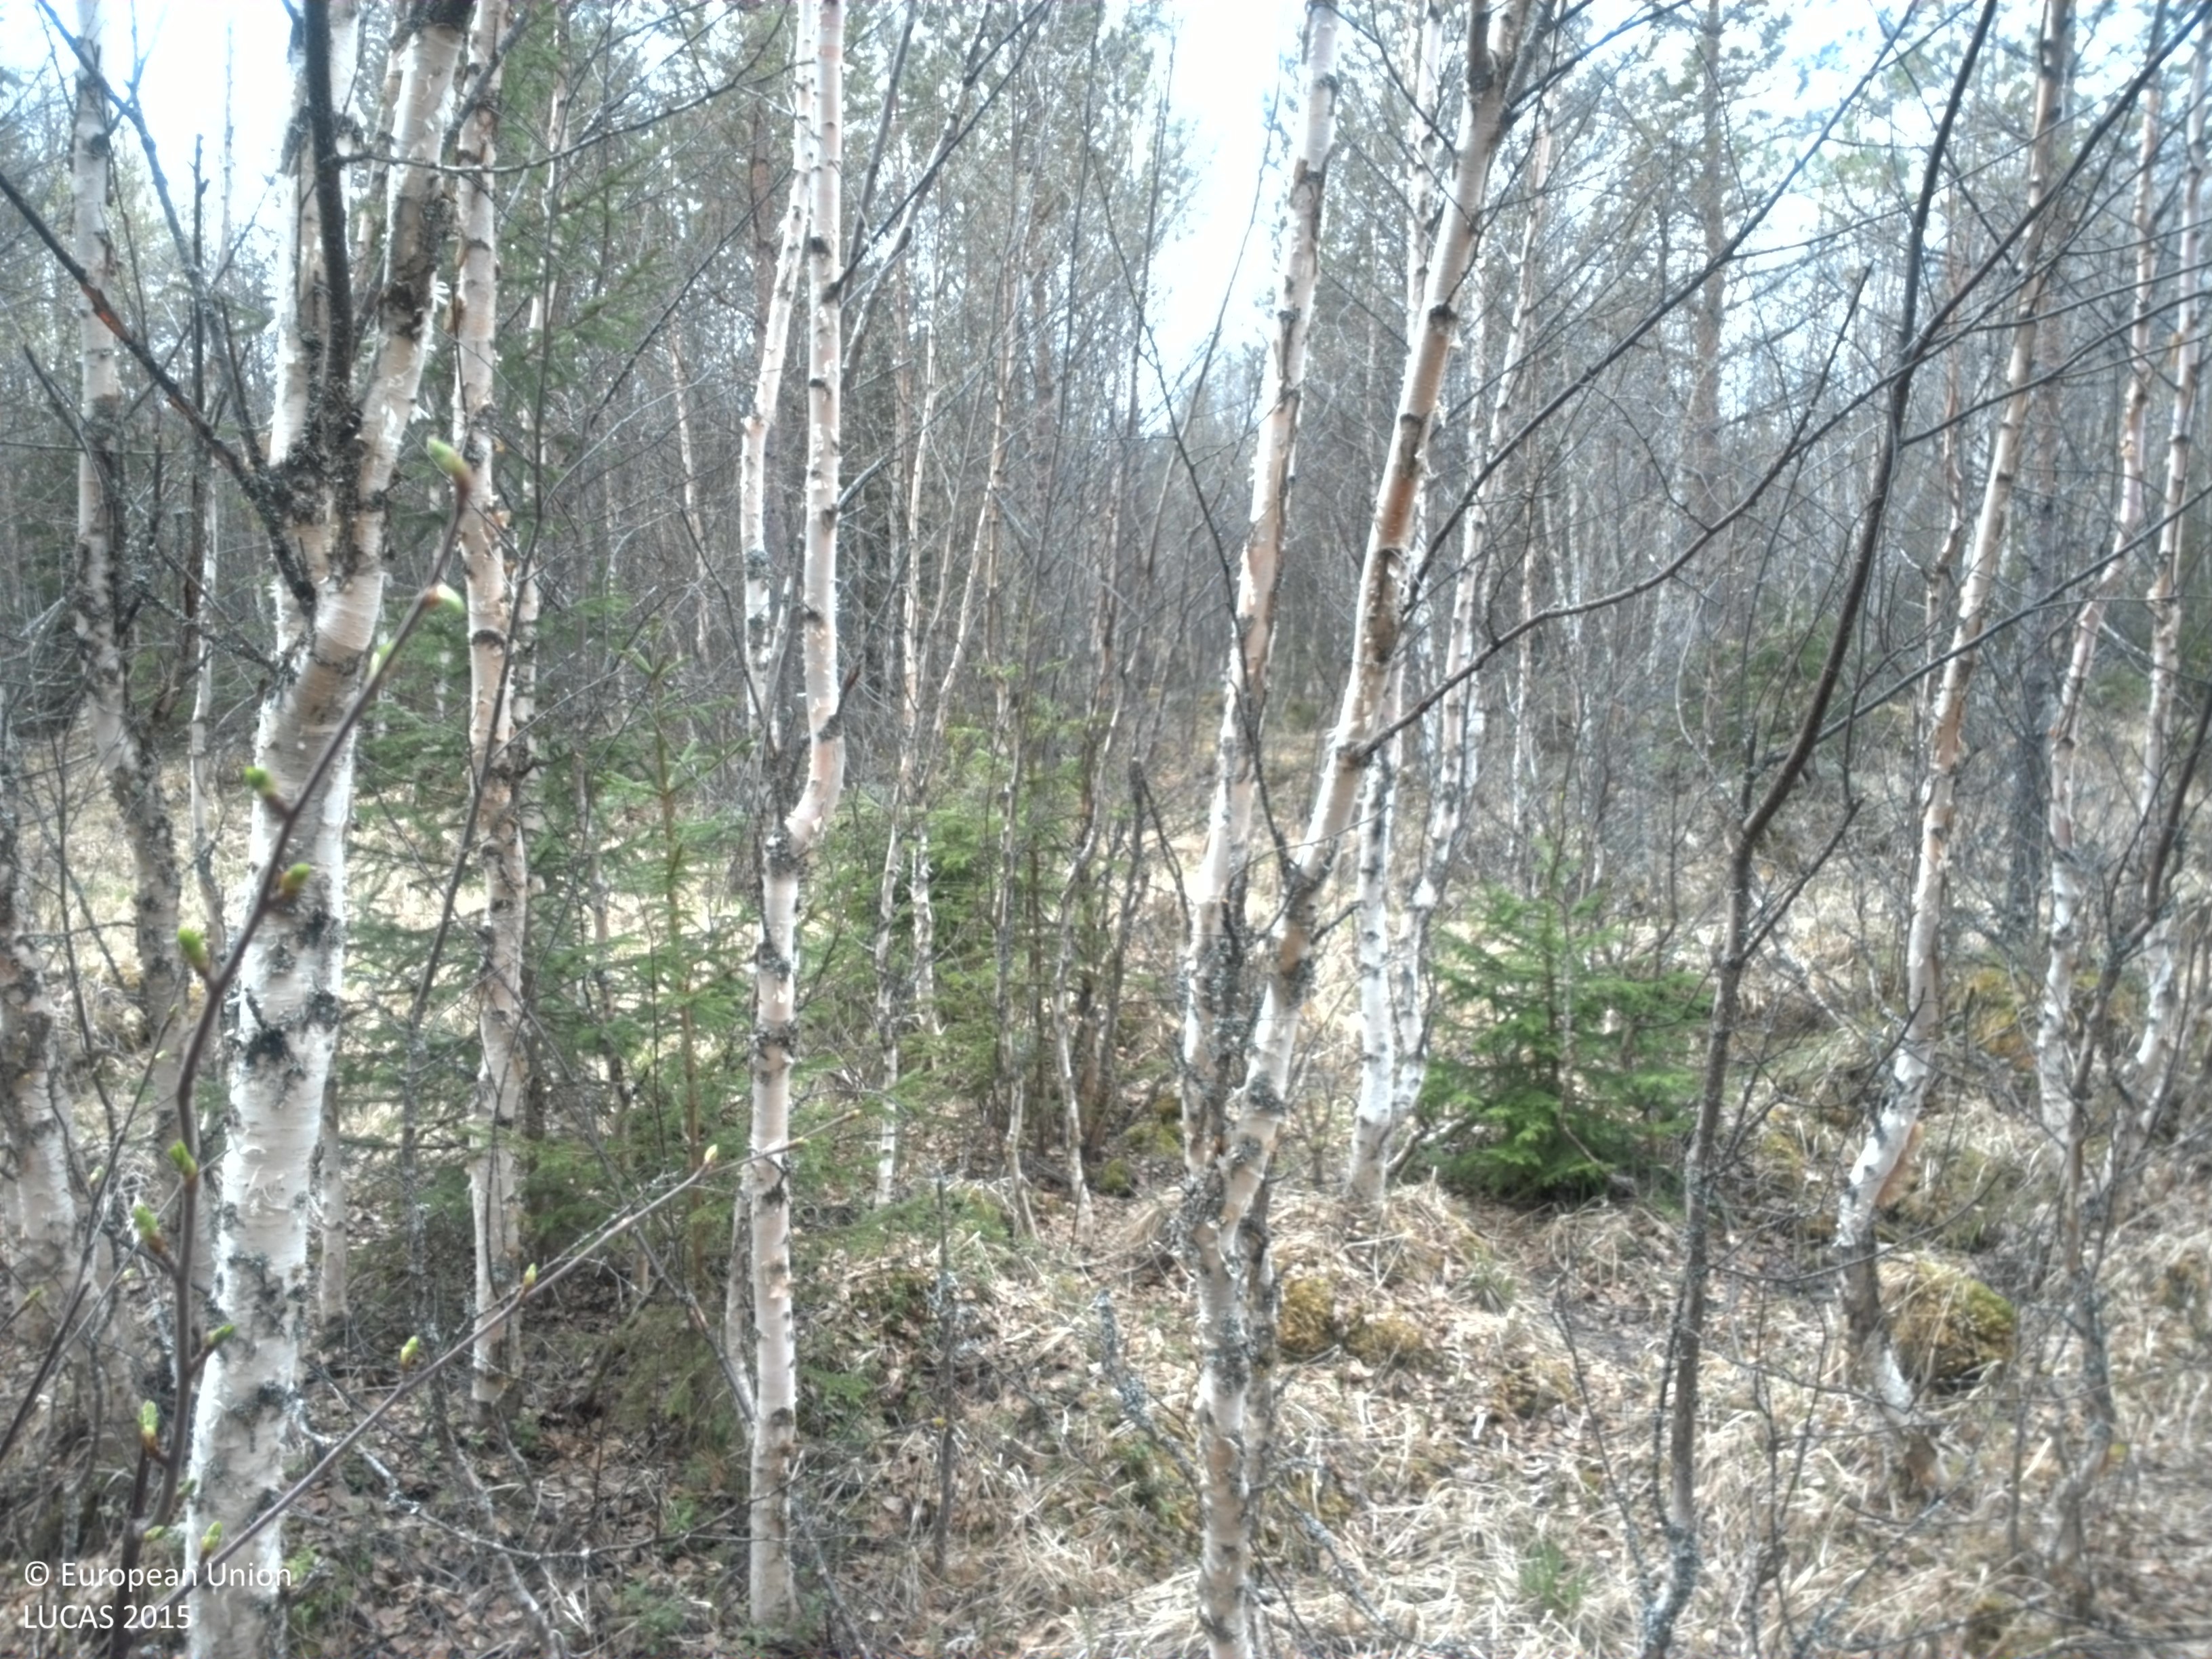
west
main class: Woodland
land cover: Other mixed woodland
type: boreal forest
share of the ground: > 75 %
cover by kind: broadleaved forest trees 40 %, coniferous forest trees 35 %, herbaceous plants 20 %, shrubs 5 %
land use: Forestry
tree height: > 5 m
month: May
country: SE
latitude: 63.3224
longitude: 15.0678
